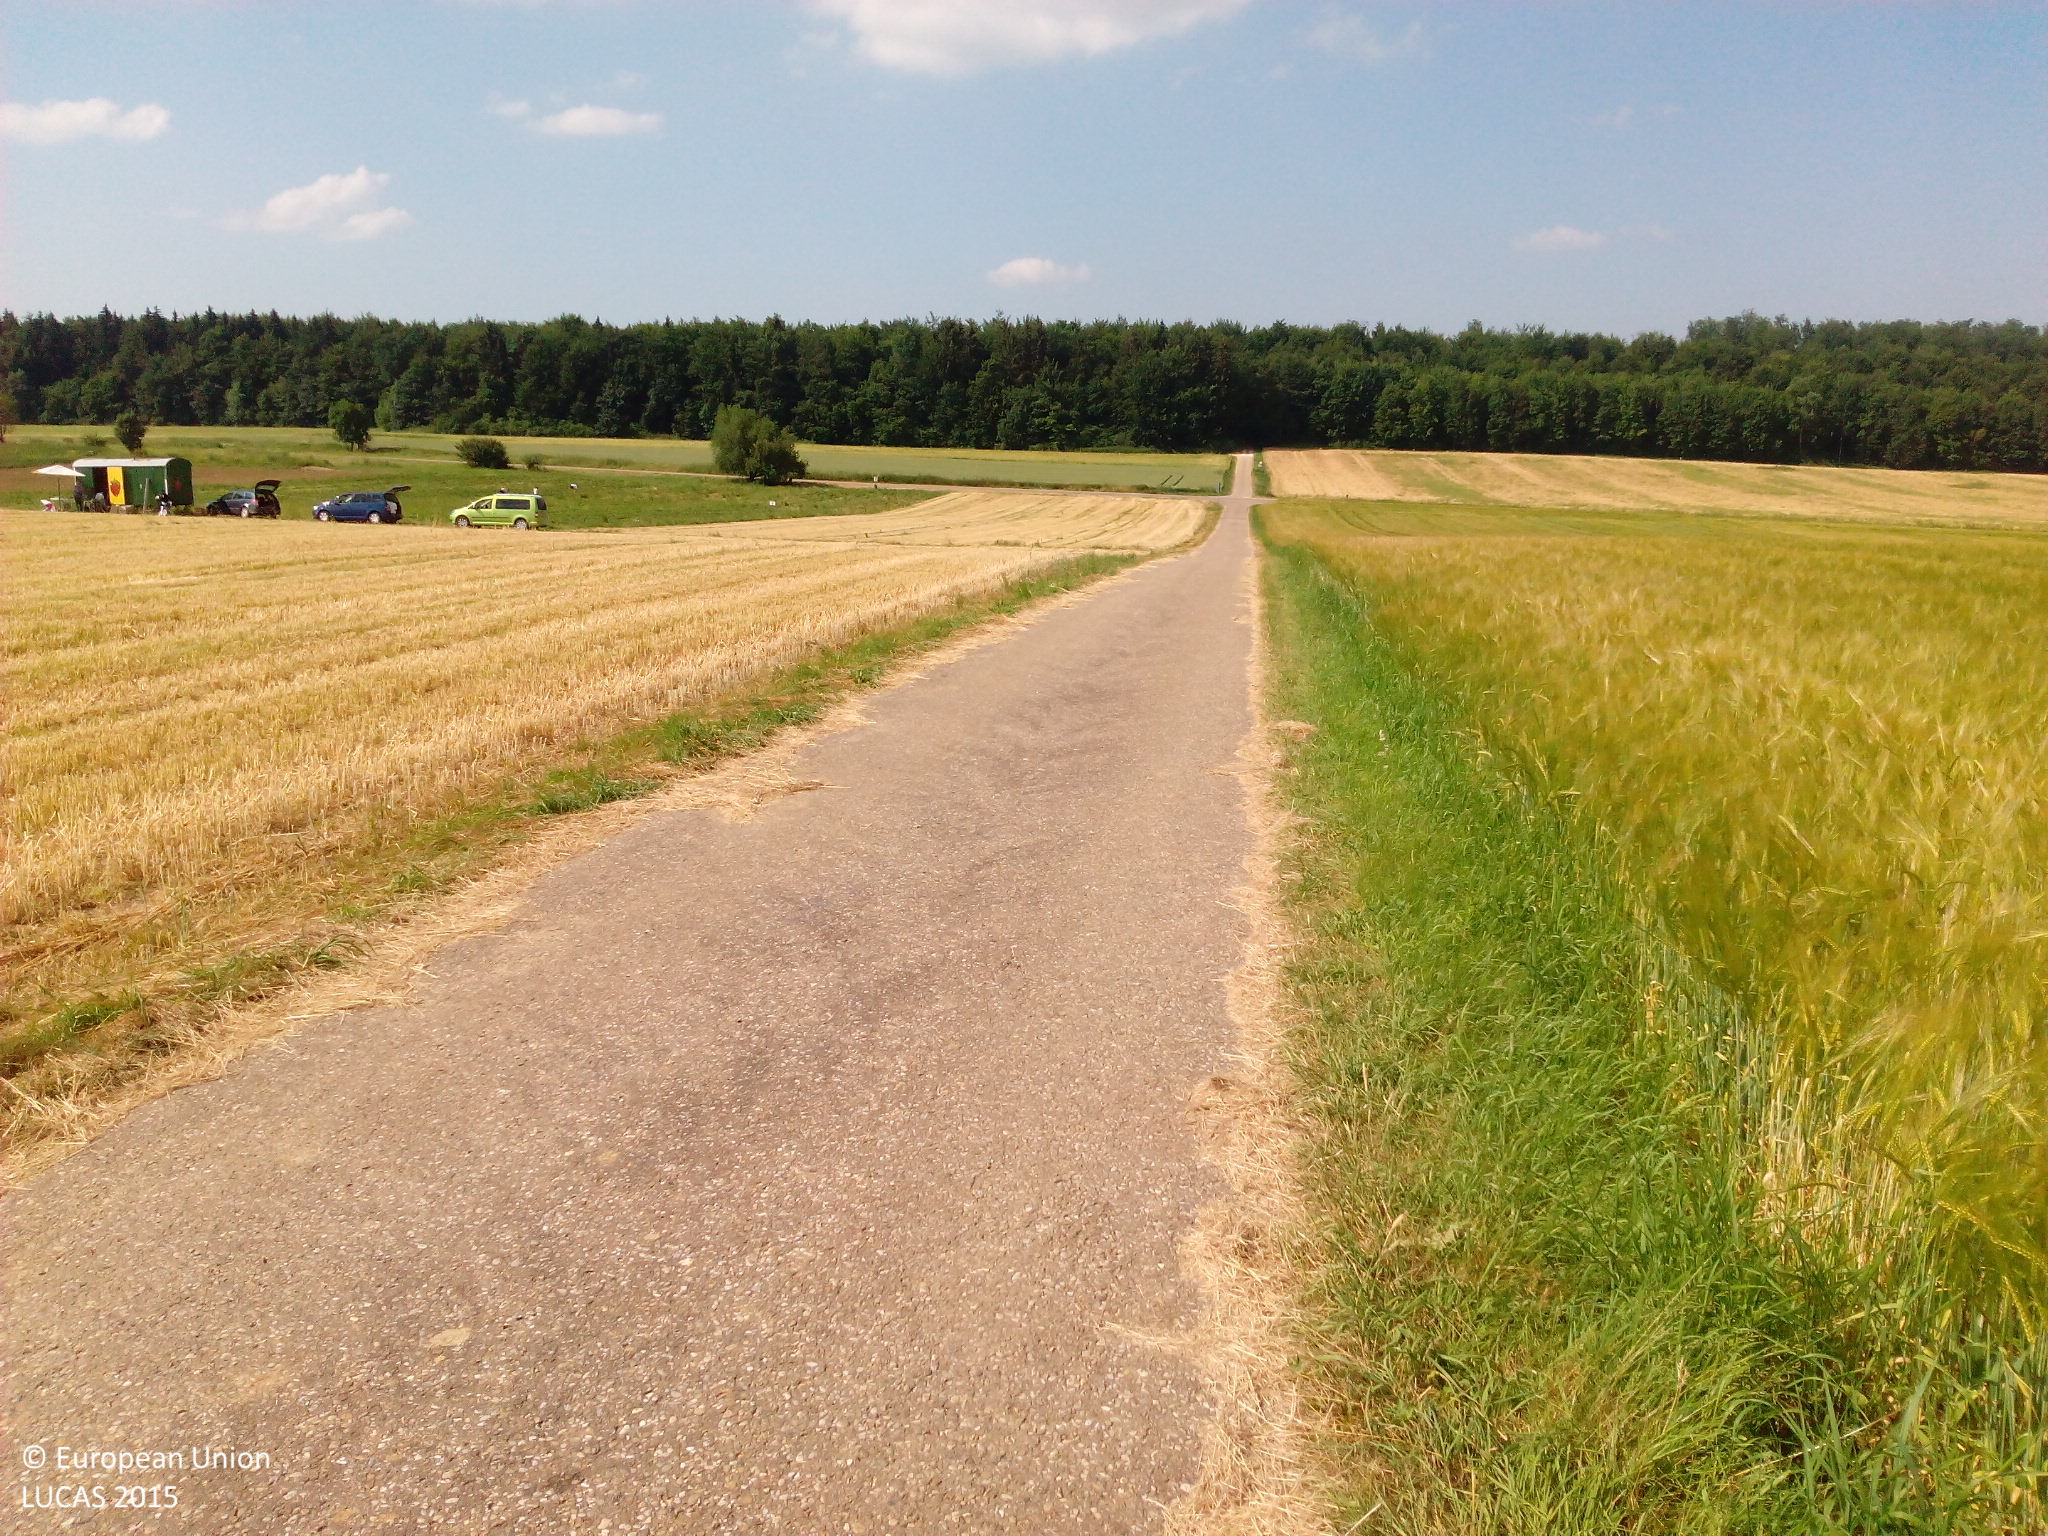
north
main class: Cropland
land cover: Barley
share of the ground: > 75 %
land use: Agriculture (excluding fallow land and kitchen gardens)
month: July
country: DE
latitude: 48.4390
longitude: 9.6893
